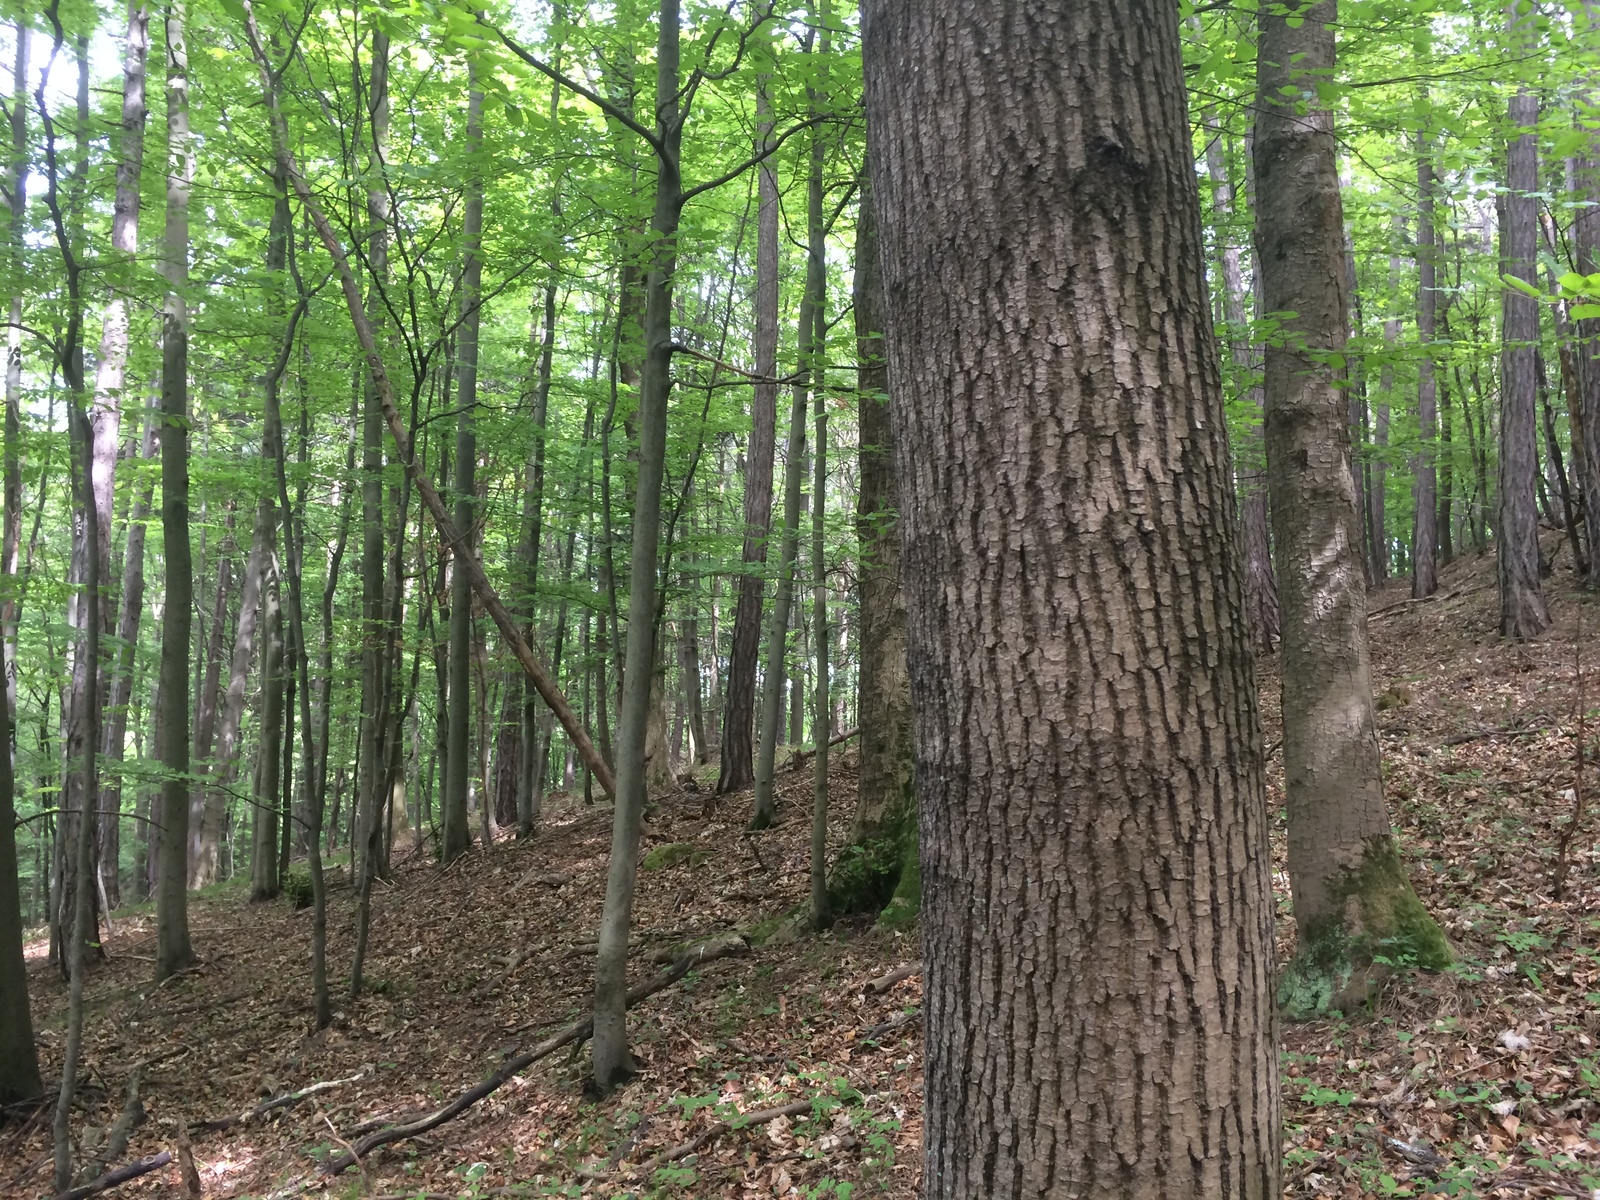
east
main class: Woodland
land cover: Other mixed woodland
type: alpine coniferous forest
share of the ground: > 75 %
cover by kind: broadleaved forest trees 60 %, coniferous forest trees 40 %
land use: Forestry
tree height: > 5 m
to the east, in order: Other mixed woodland; Pine dominated mixed woodland; Spruce dominated mixed woodland; Tracks; Pine dominated mixed woodland; Spruce dominated mixed woodland
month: May
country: AT
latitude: 47.9078
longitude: 16.1445
